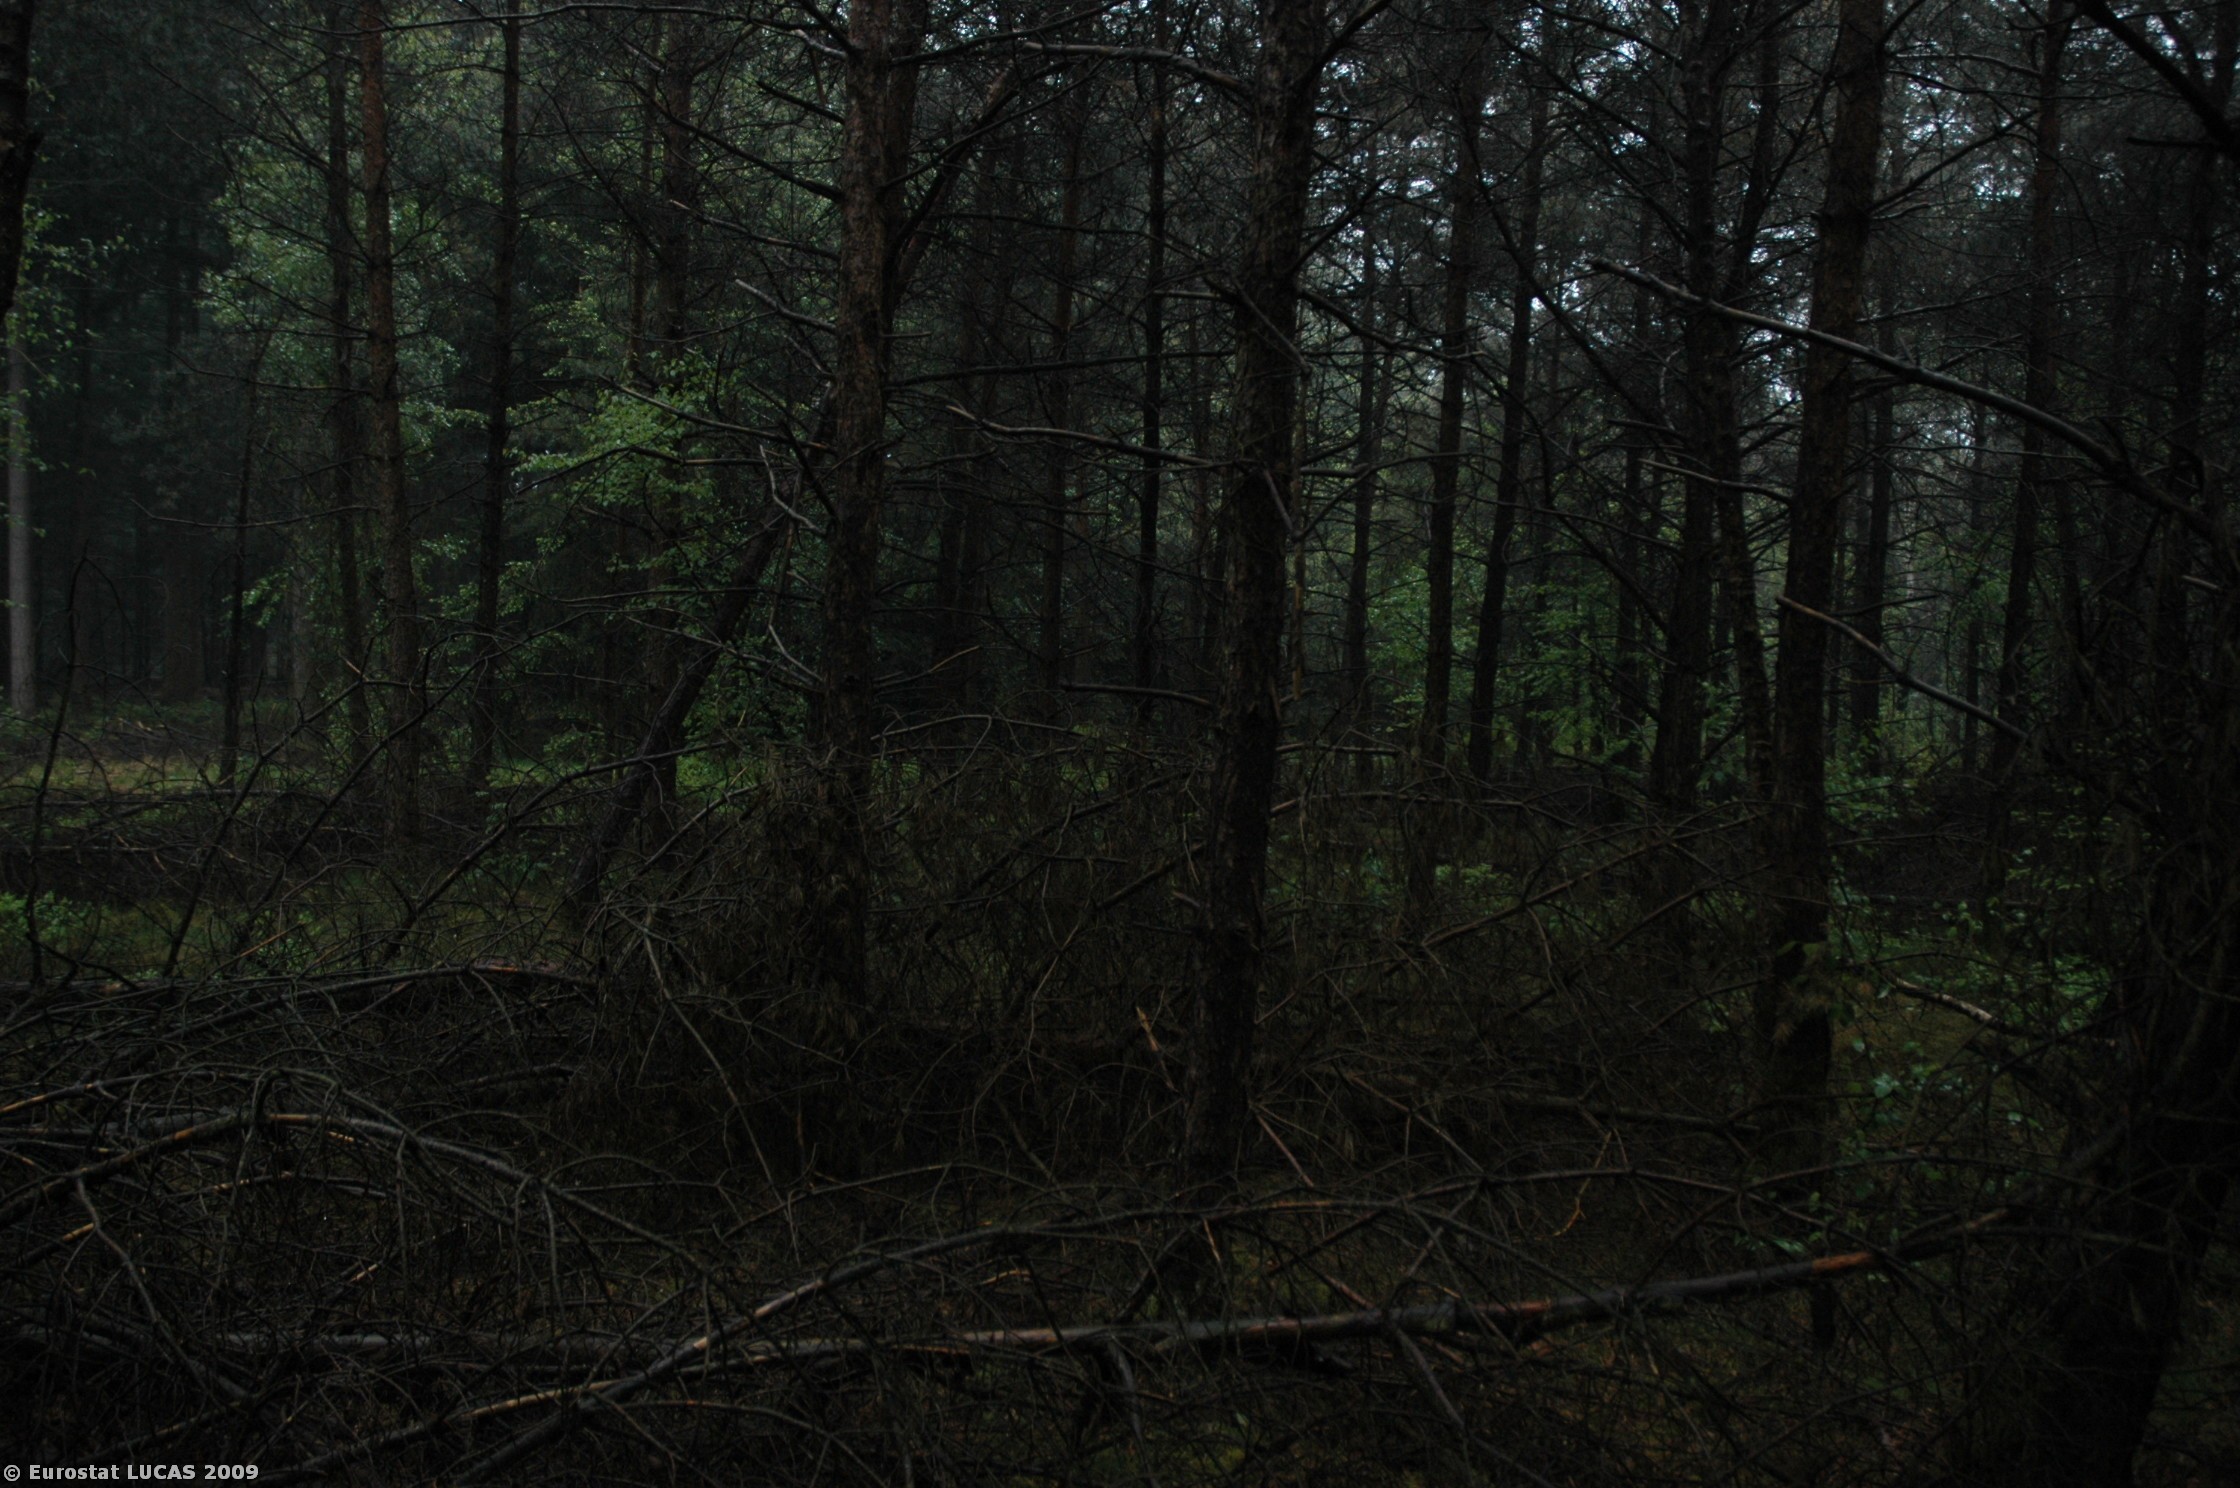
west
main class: Woodland
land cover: Mixed woodland
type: hemiboreal forest and nemoral coniferous forest and mixed broadleaved-coniferous forest
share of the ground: > 75 %
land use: Amenities, museums, leisure
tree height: > 5 m
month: May
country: NL
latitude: 52.1049
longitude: 5.3113
